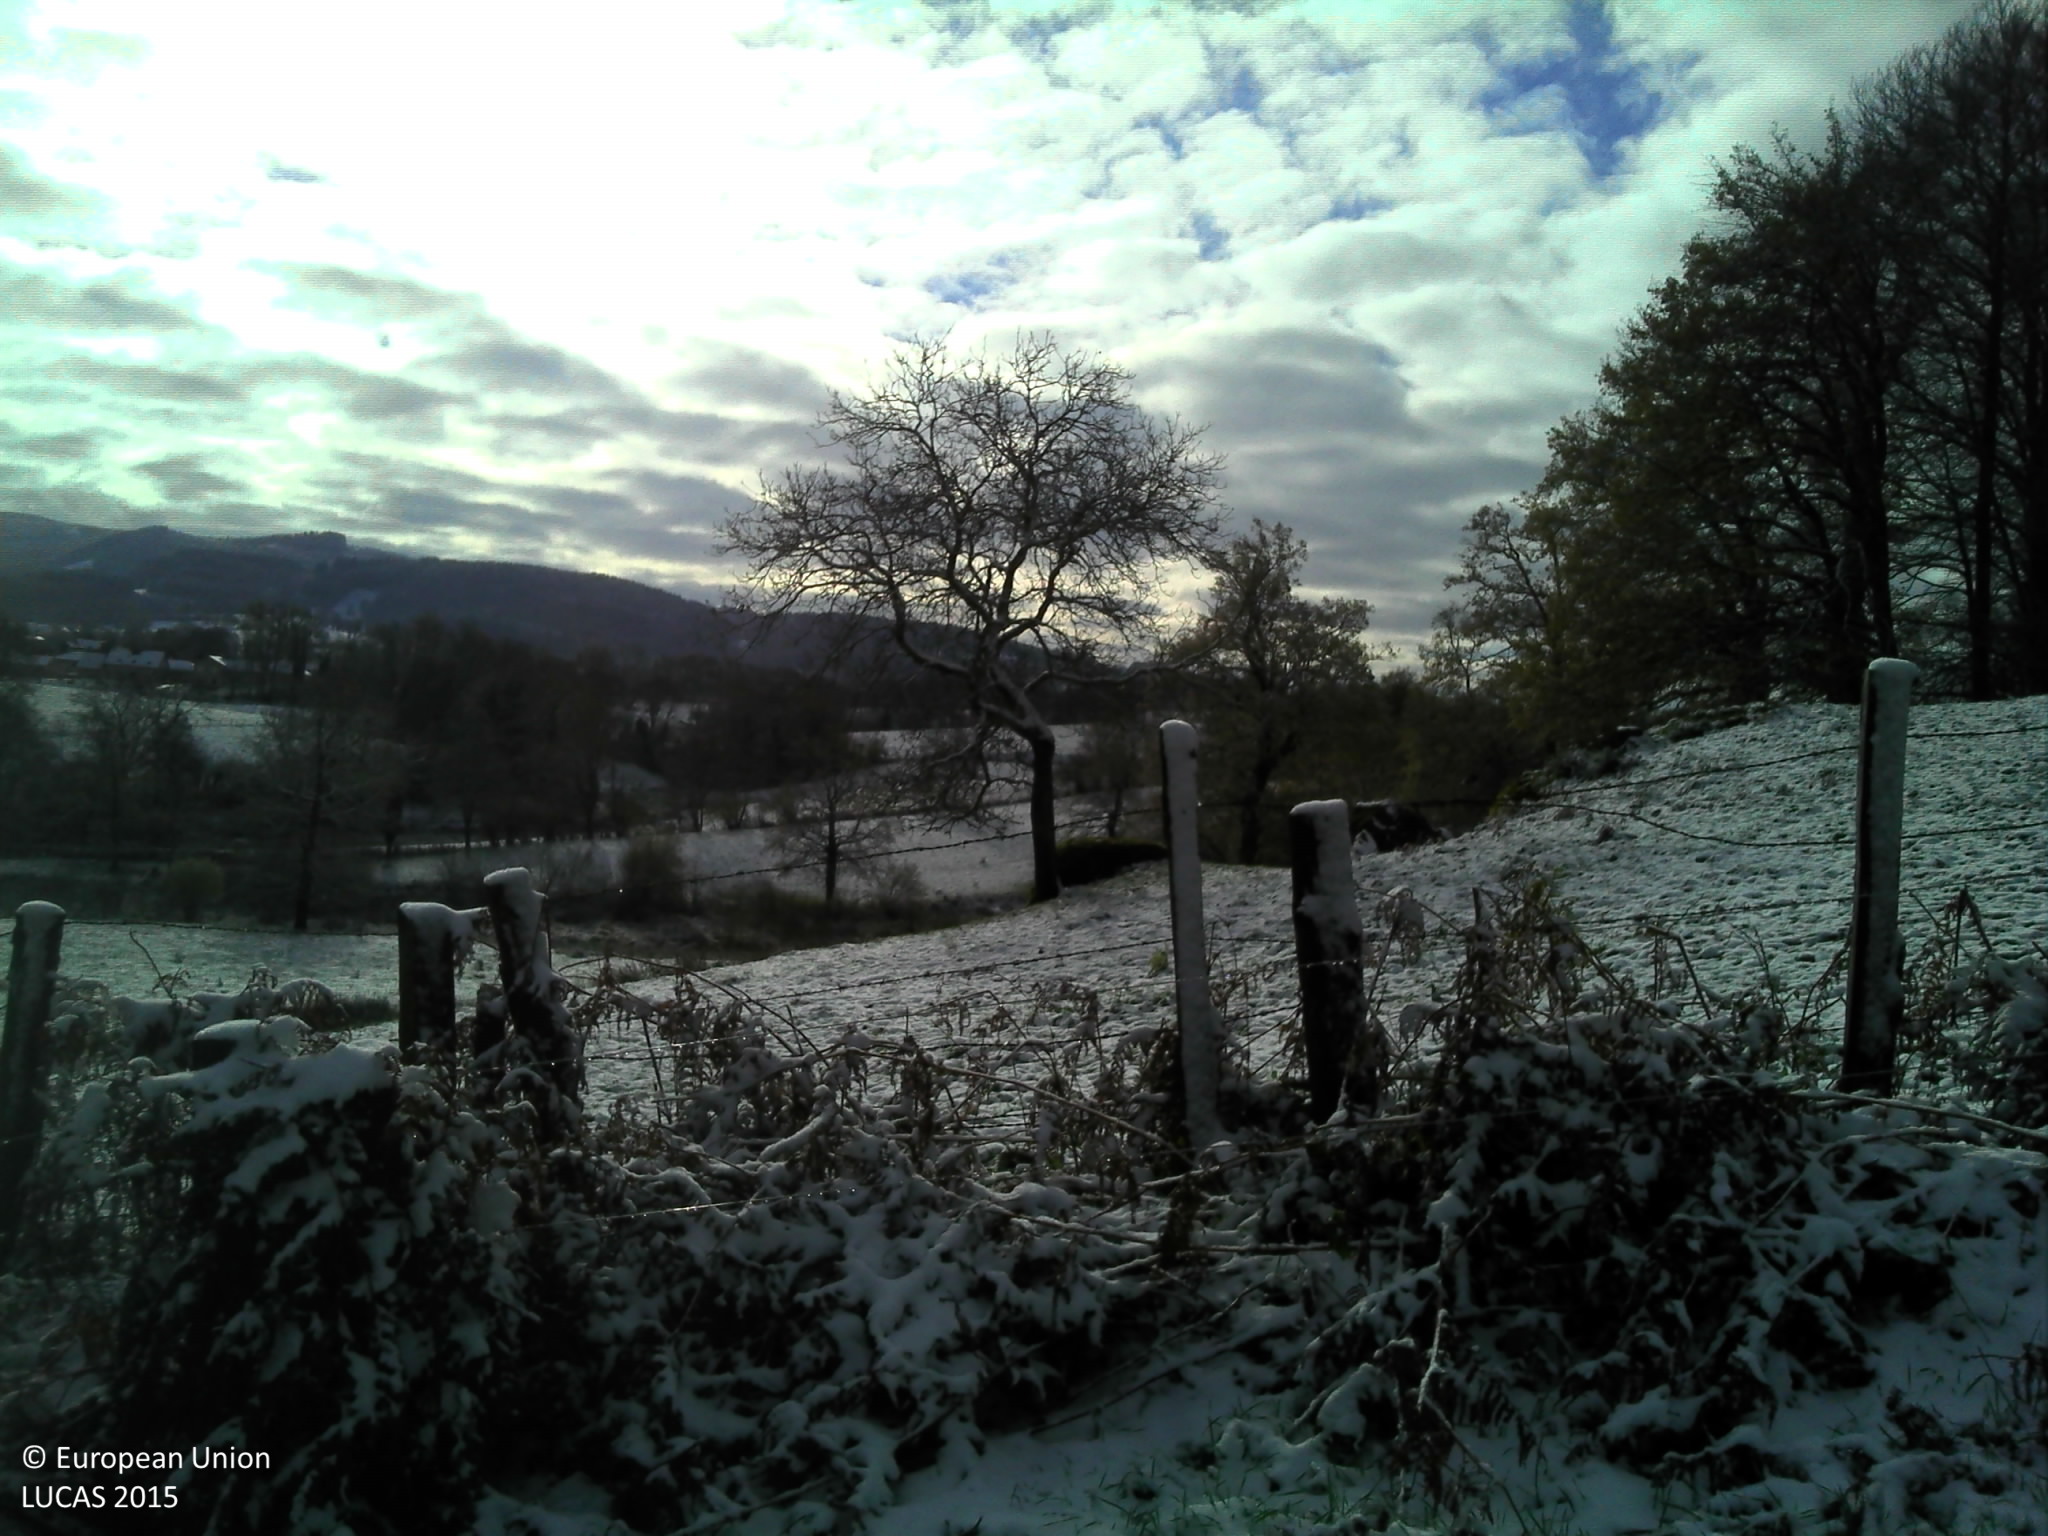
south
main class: Grassland
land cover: Grassland without tree/shrub cover
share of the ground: > 75 %
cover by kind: herbaceous plants 100 %
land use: Agriculture (excluding fallow land and kitchen gardens)
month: November
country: FR
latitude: 46.0723
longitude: 3.6522
